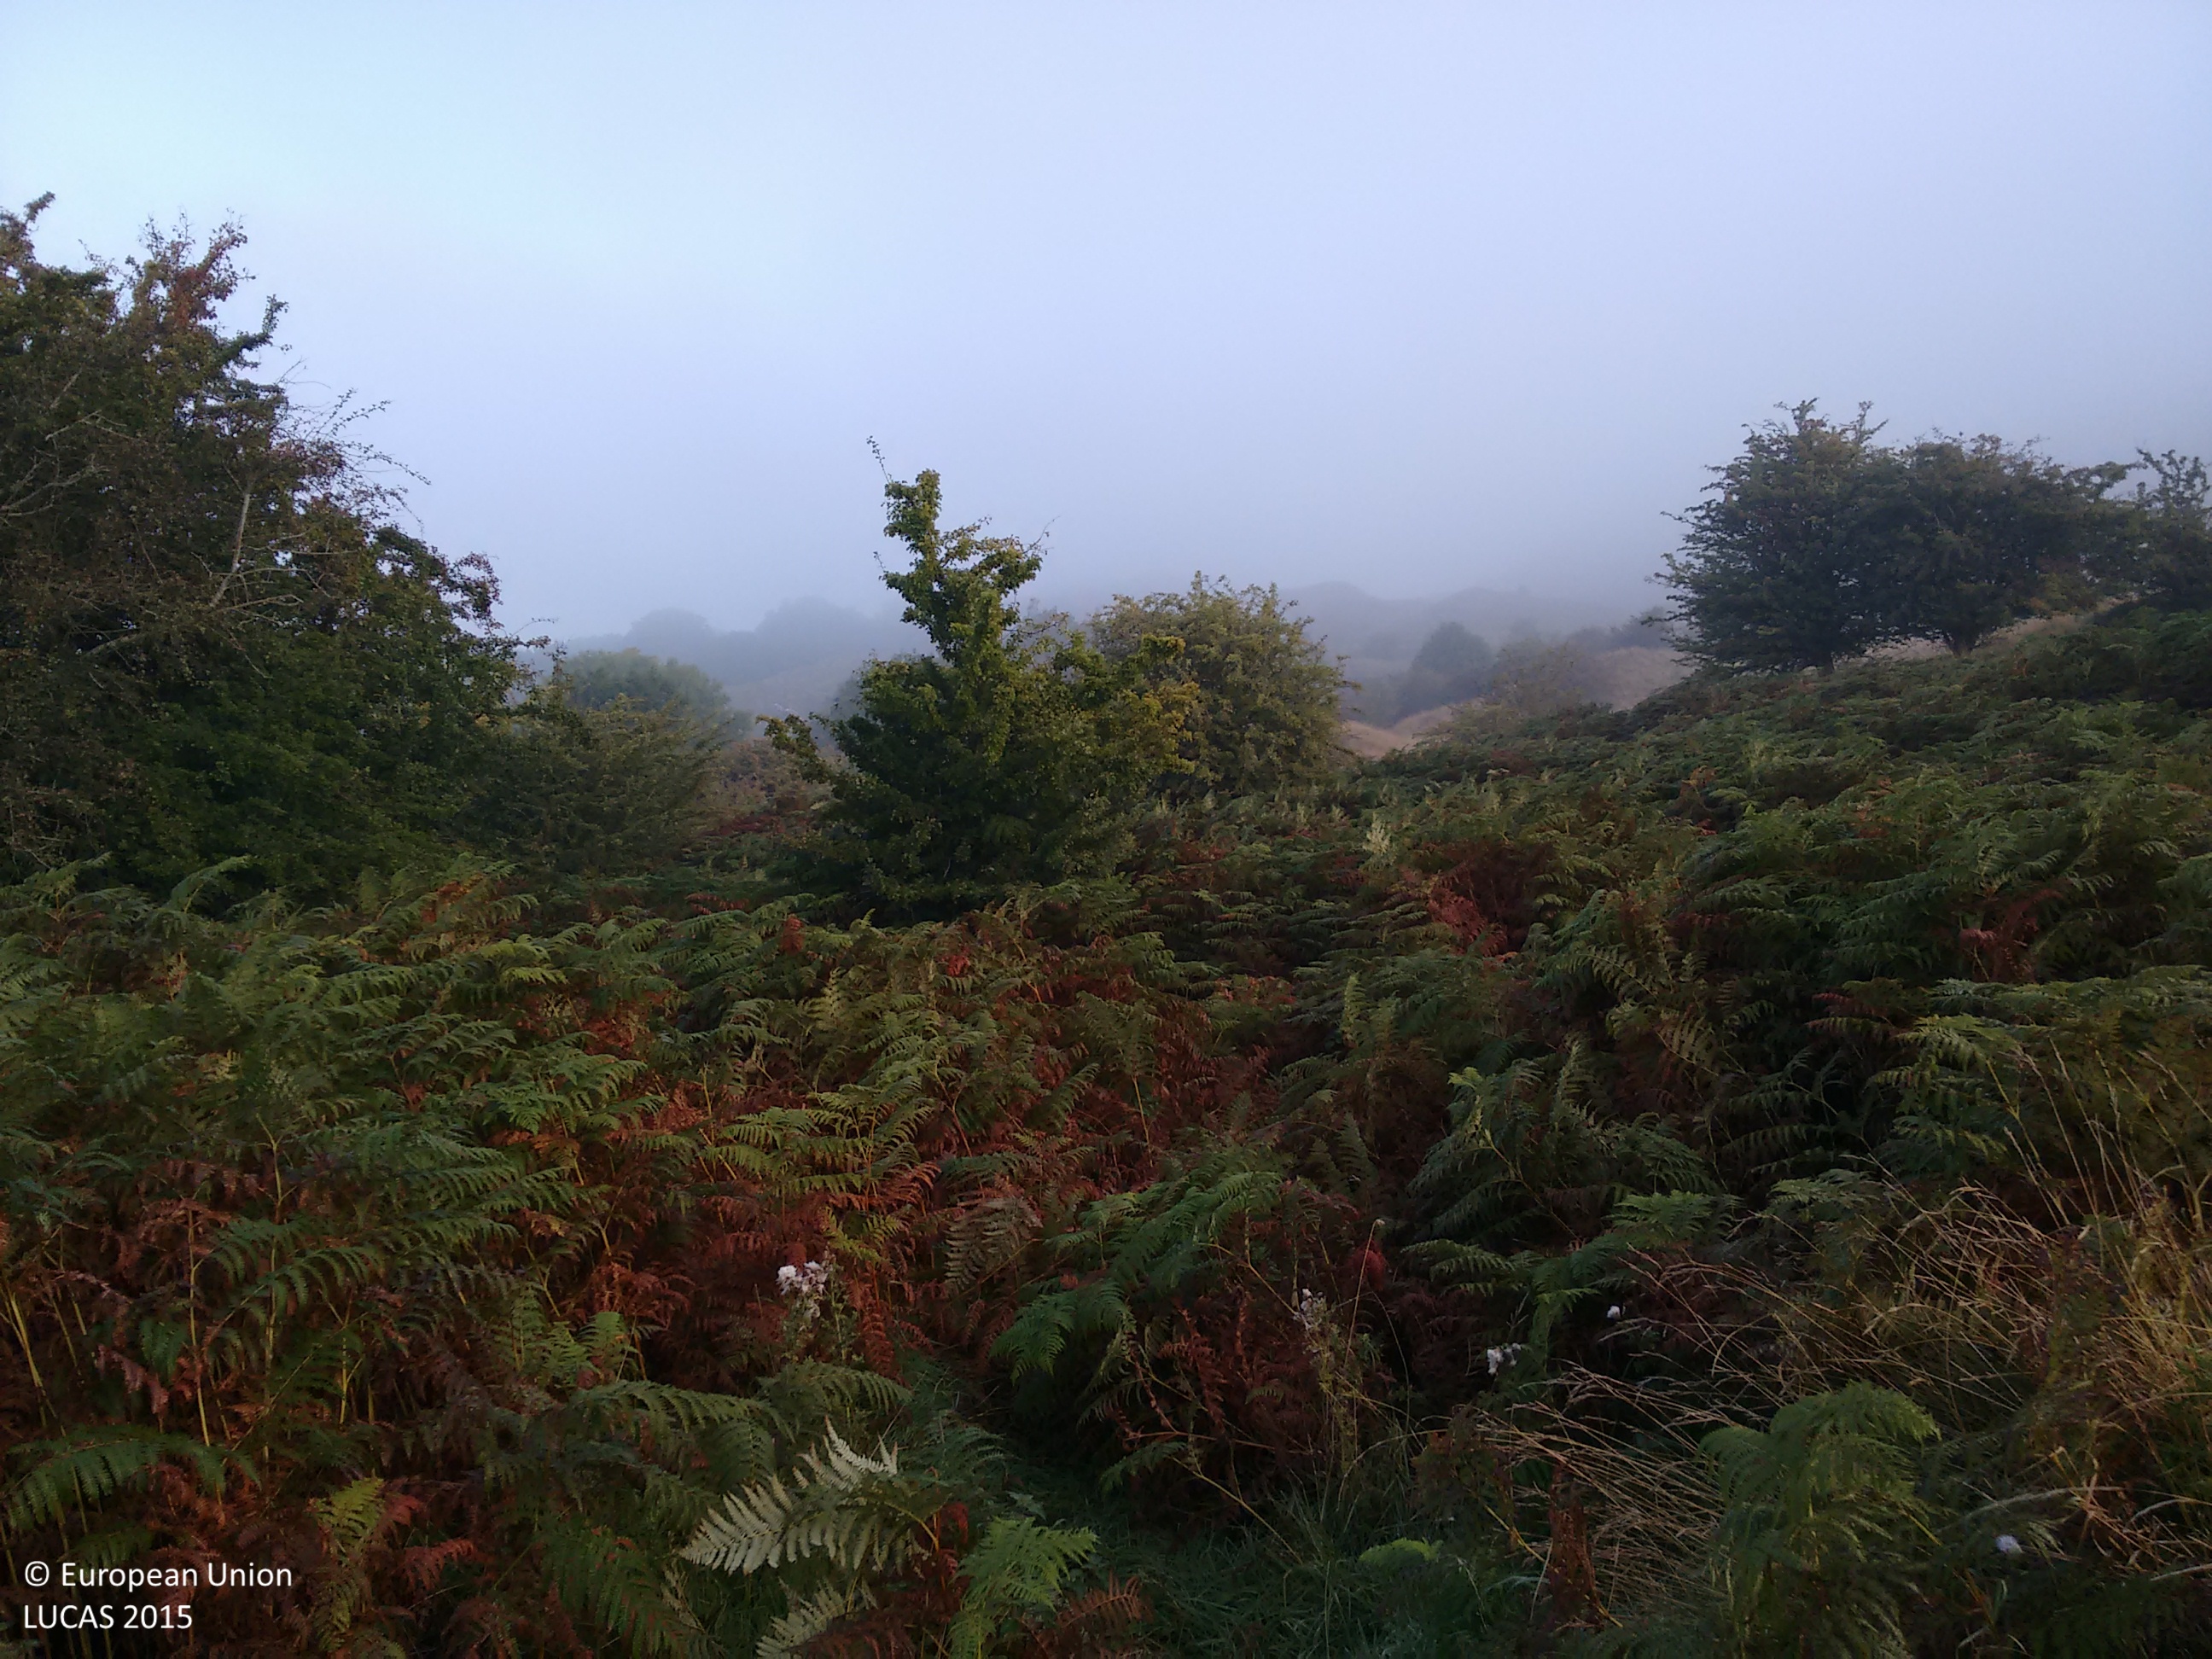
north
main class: Shrubland
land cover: Shrubland with sparse tree cover
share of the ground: > 75 %
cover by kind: herbaceous plants 60 %, shrubs 35 %, broadleaved forest trees 5 %
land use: Agriculture (excluding fallow land and kitchen gardens)
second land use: Community services
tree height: < 5 m
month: September
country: GB
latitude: 51.9270
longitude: -2.0270
